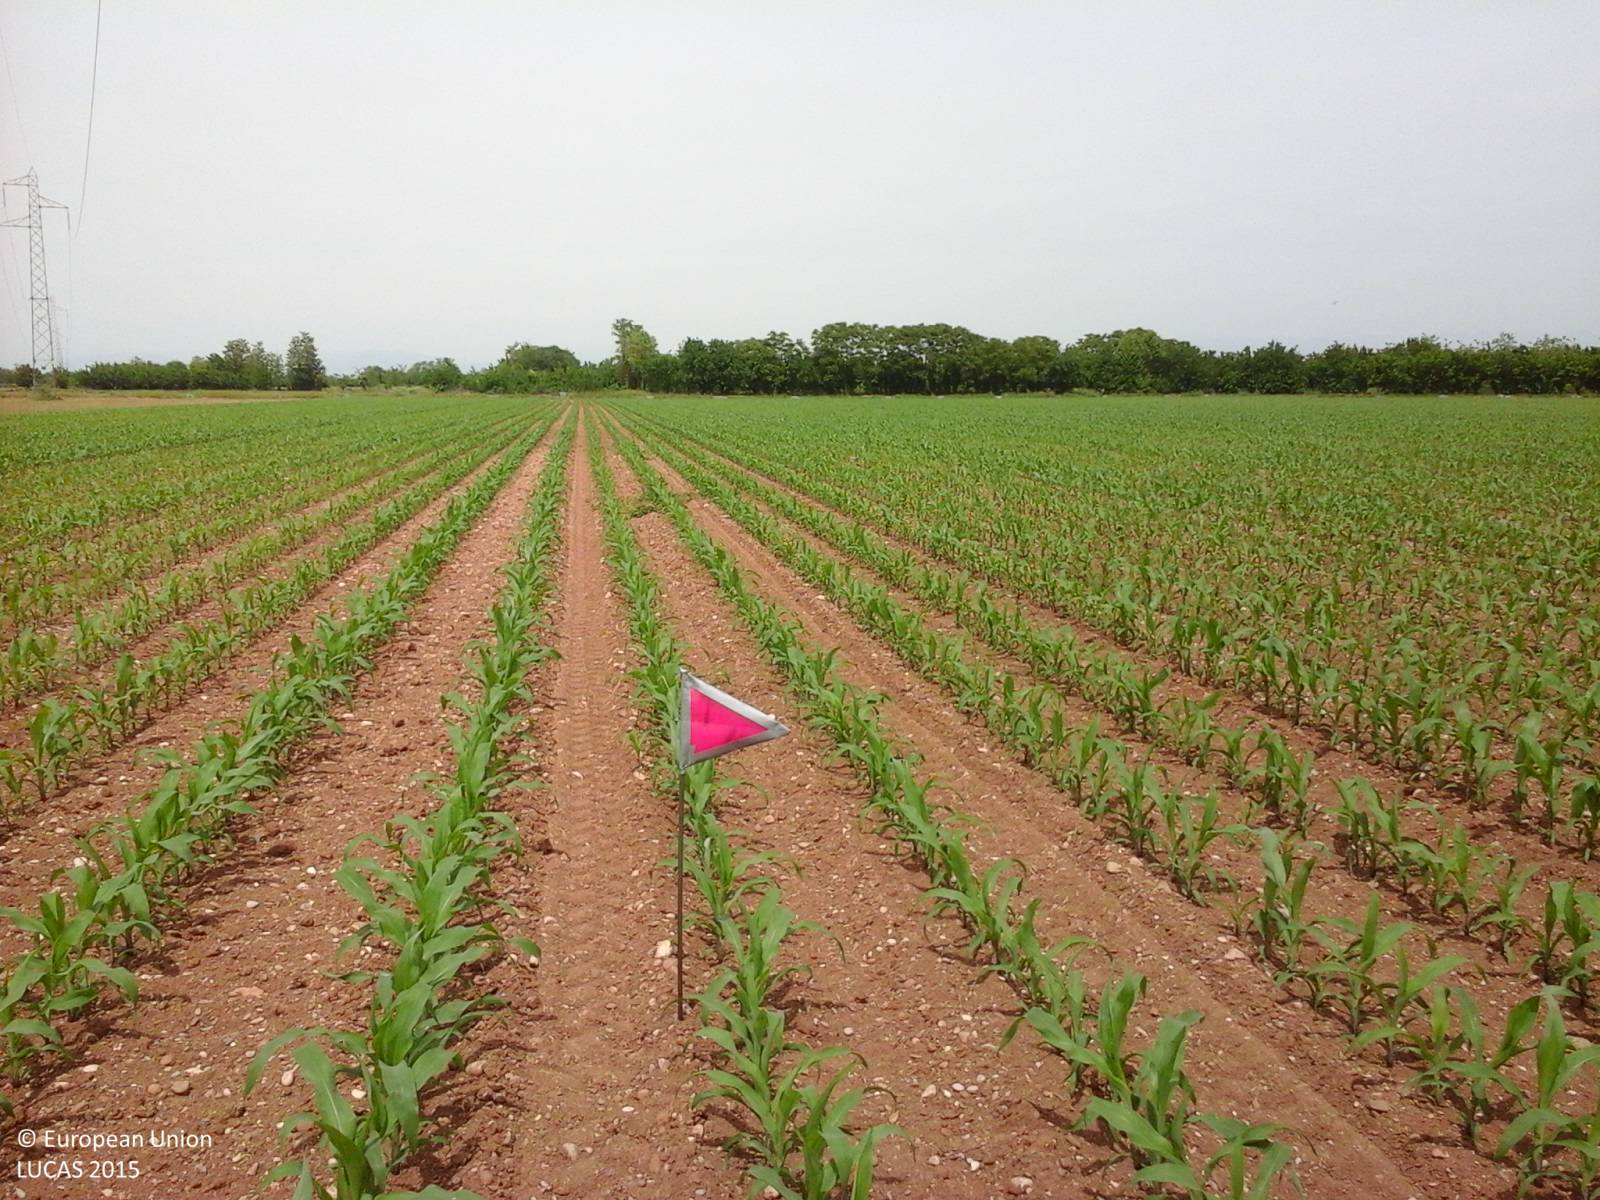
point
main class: Cropland
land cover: Maize
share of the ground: 25 - 50 %
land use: Agriculture (excluding fallow land and kitchen gardens)
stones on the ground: 10 - 25 %
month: May
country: IT
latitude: 45.9066
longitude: 13.2060
